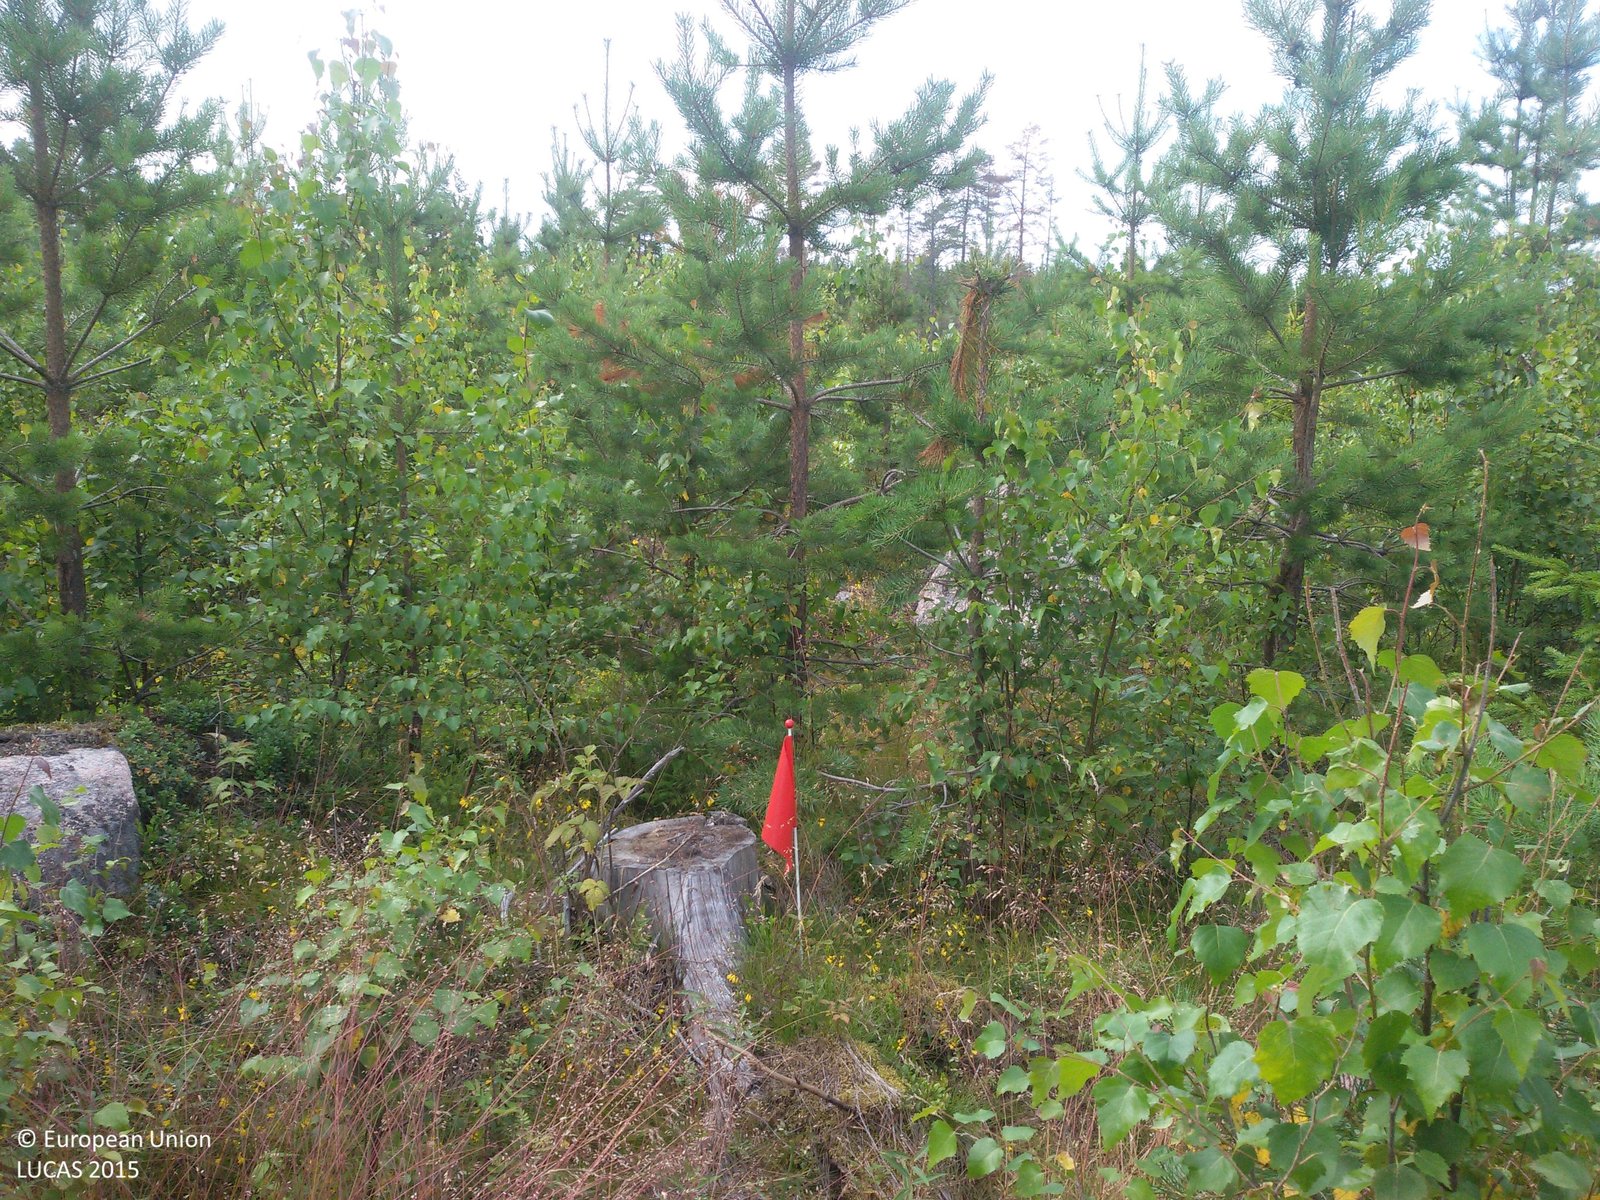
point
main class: Woodland
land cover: Pine dominated mixed woodland
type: boreal forest
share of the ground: > 75 %
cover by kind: coniferous forest trees 45 %, broadleaved forest trees 40 %, herbaceous plants 15 %
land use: Forestry
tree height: < 5 m
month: August
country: SE
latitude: 60.4100
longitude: 16.5067
